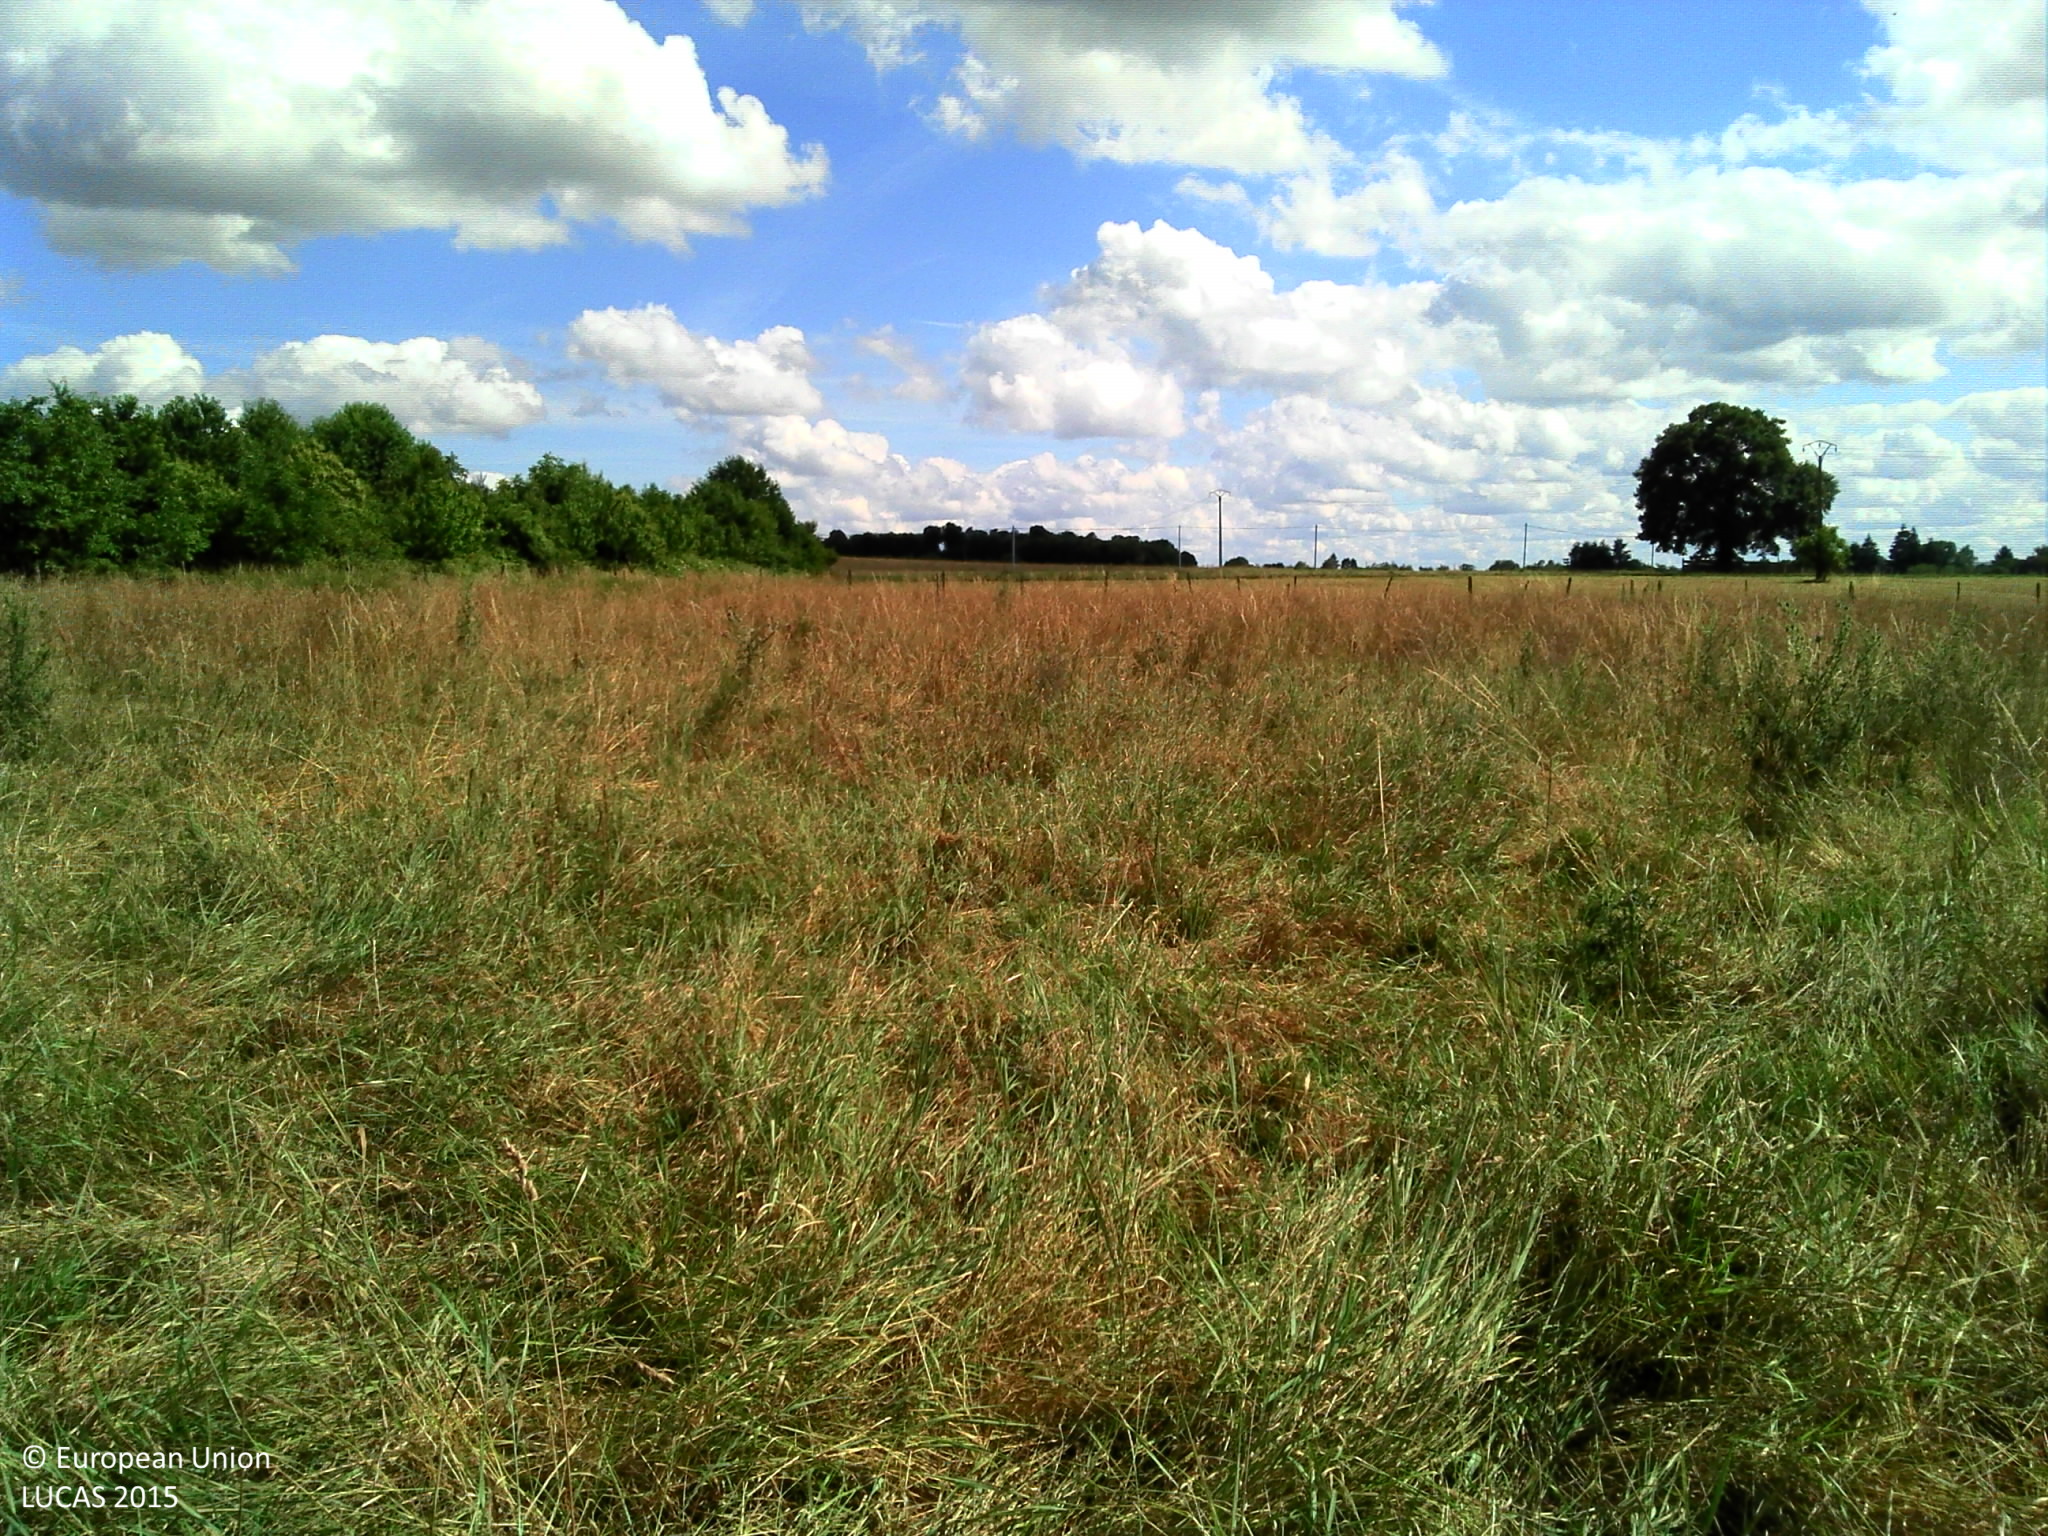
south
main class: Grassland
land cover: Grassland without tree/shrub cover
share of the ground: > 75 %
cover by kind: herbaceous plants 100 %
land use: Agriculture (excluding fallow land and kitchen gardens)
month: June
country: FR
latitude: 45.7047
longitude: 0.4423
